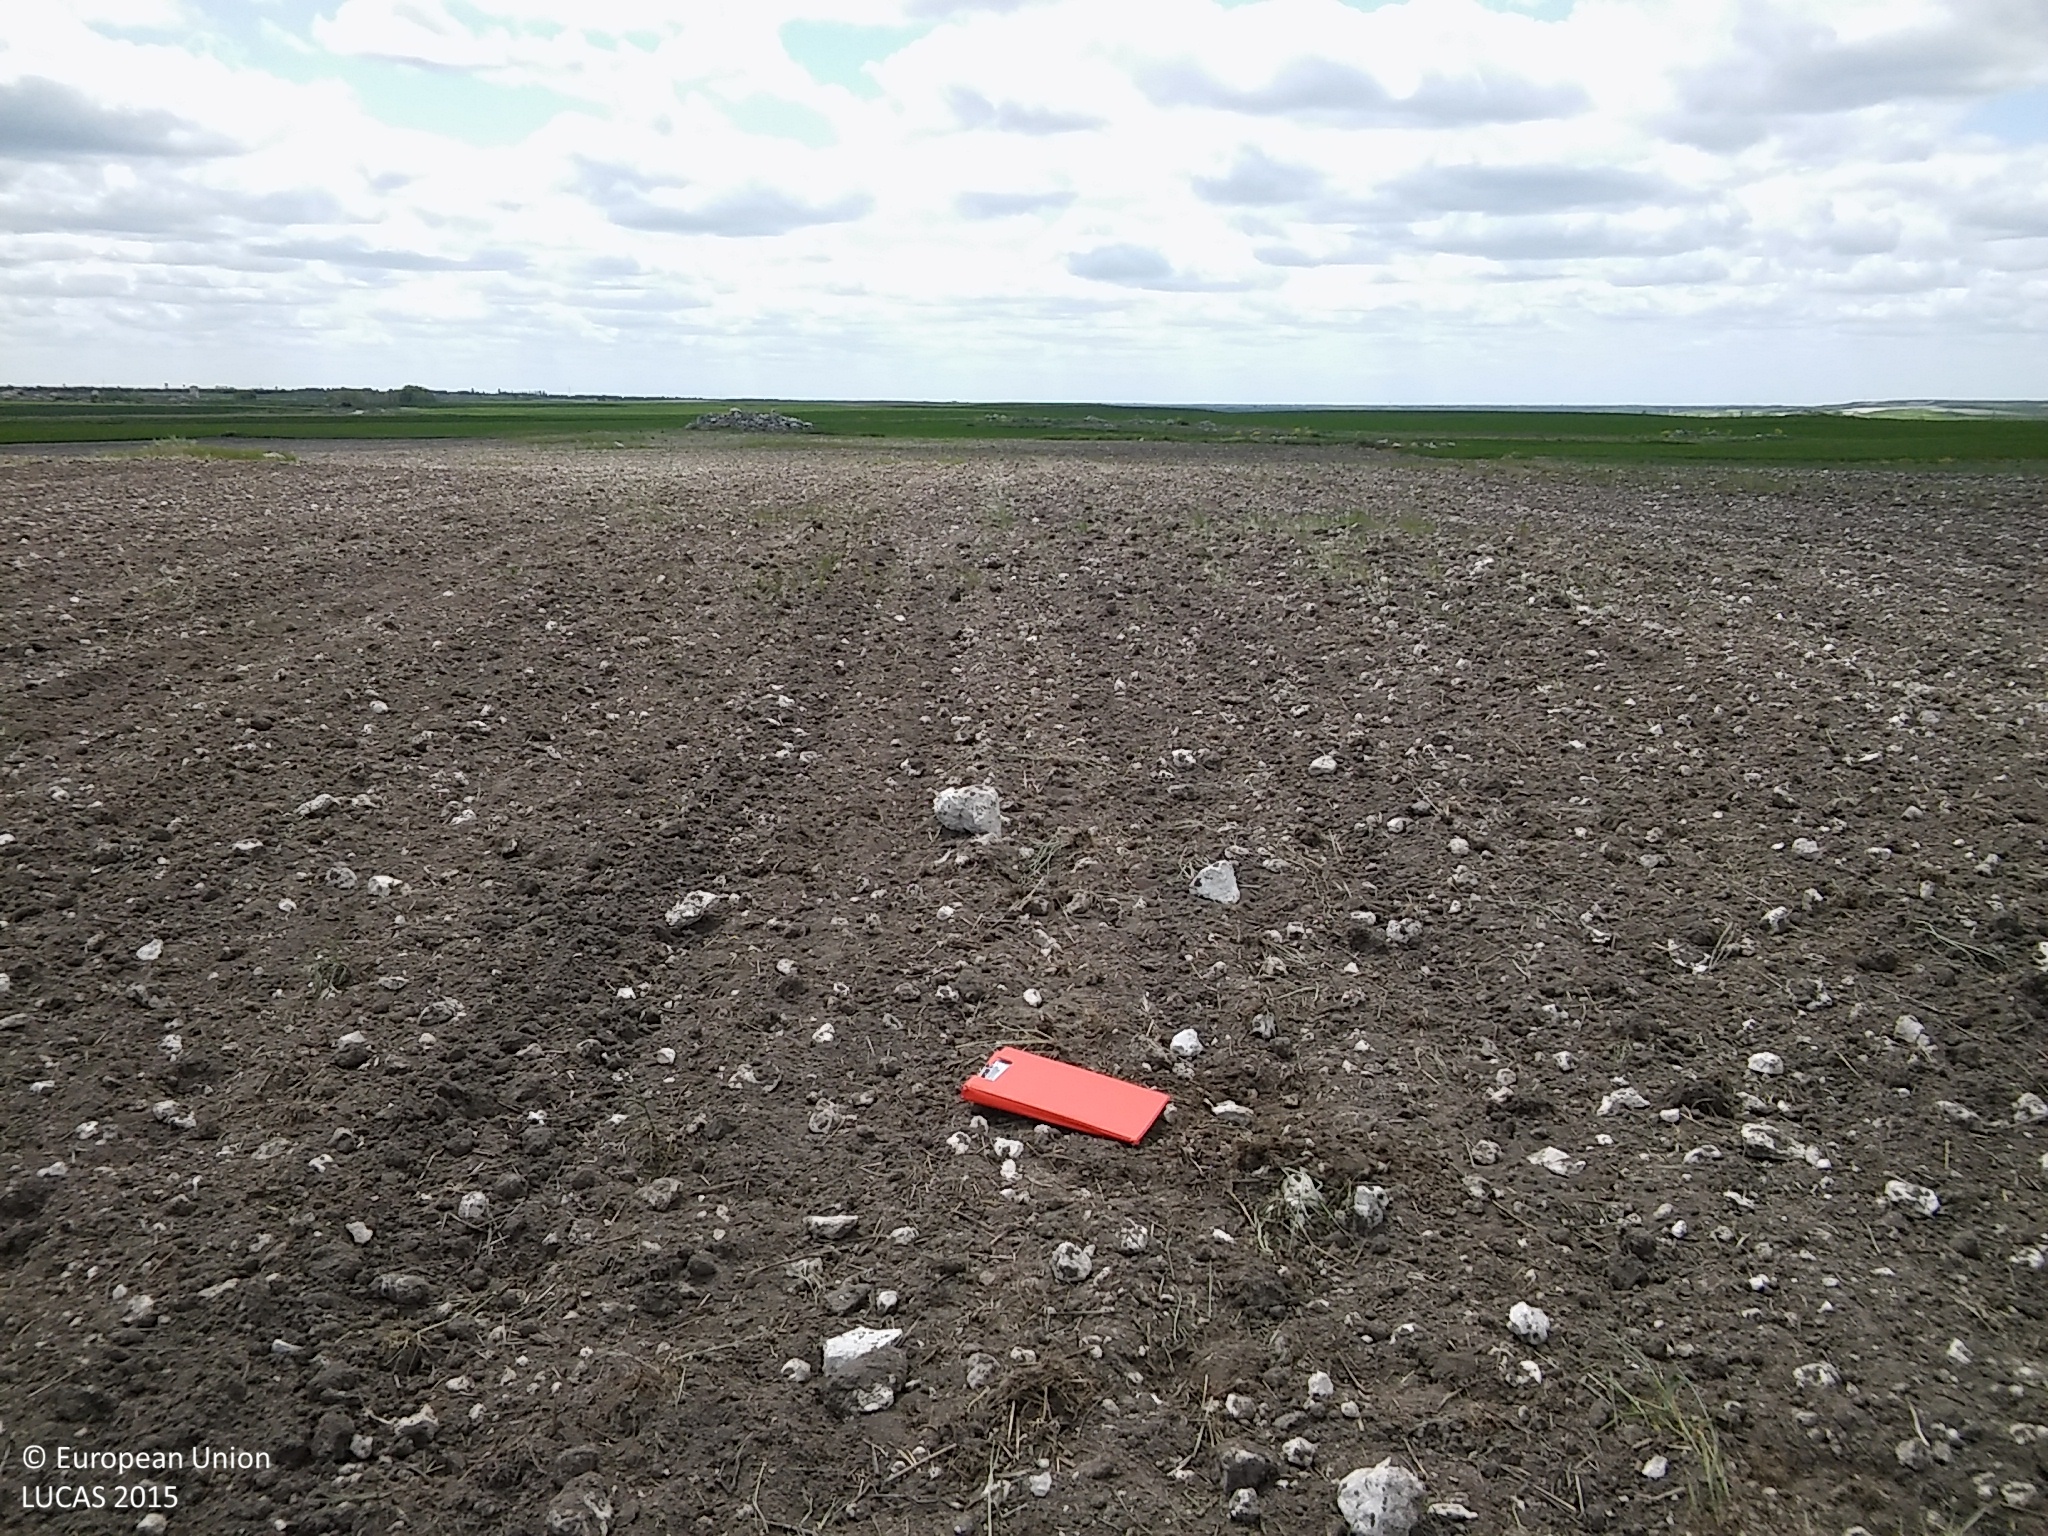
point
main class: Cropland
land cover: Sunflower
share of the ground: < 10 %
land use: Agriculture (excluding fallow land and kitchen gardens)
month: May
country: ES
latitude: 41.4075
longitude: -4.0876
